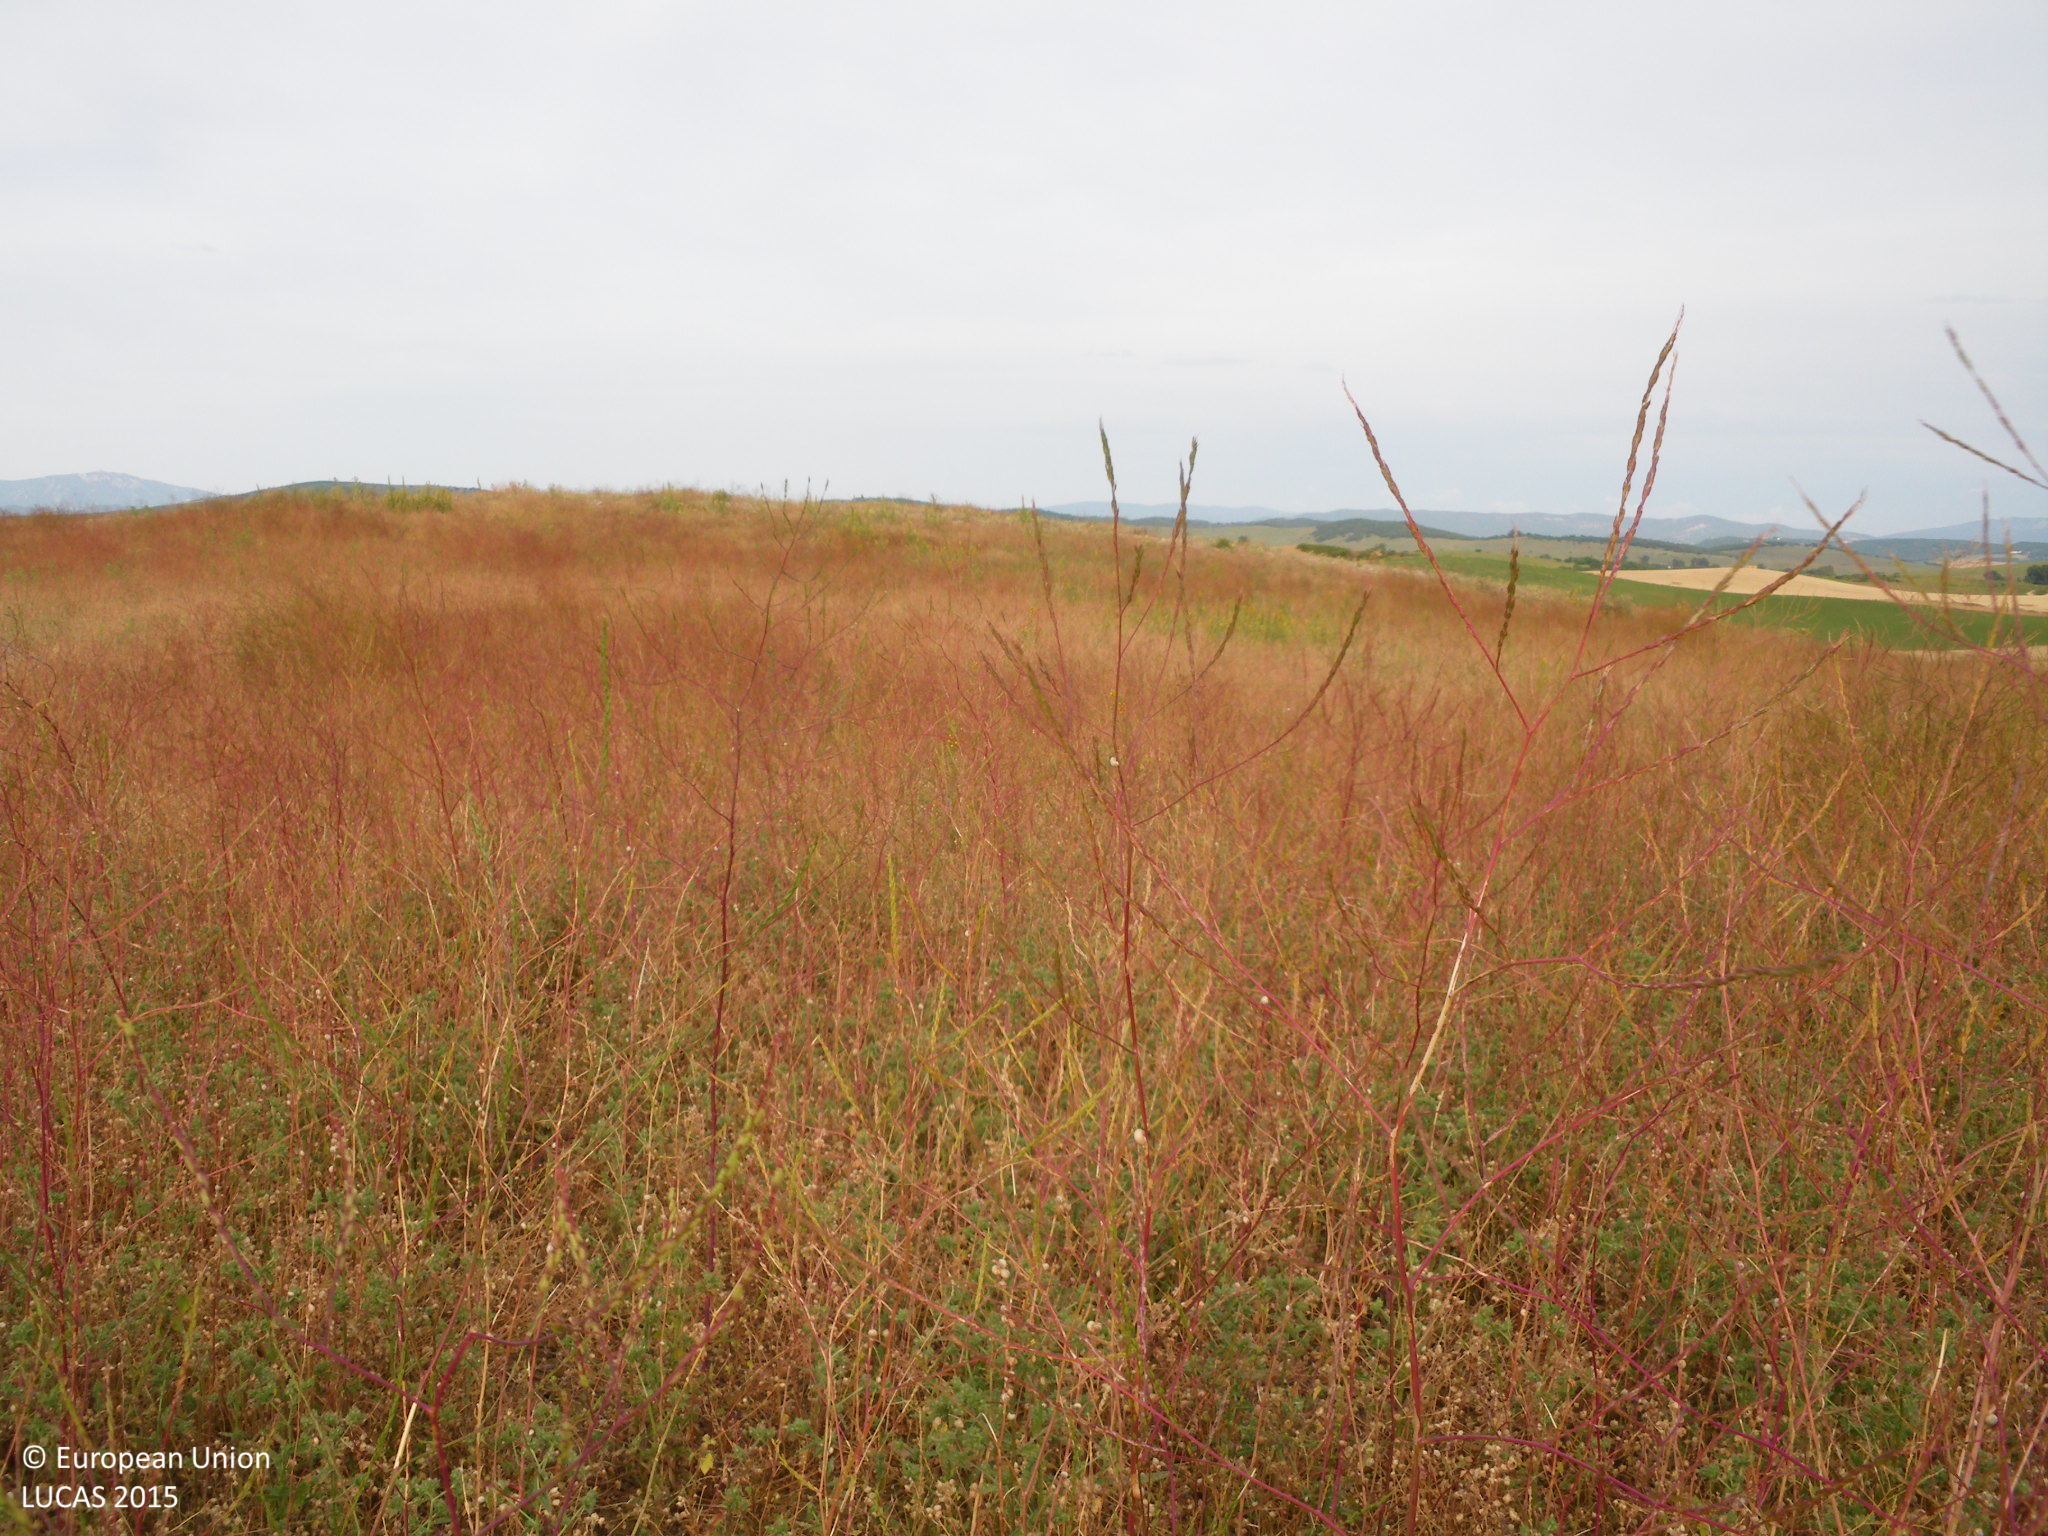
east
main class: Grassland
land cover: Spontaneously vegetated surfaces
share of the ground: > 75 %
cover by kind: herbaceous plants 95 %, unconsolidated bare surface 5 %
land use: Agriculture (excluding fallow land and kitchen gardens)
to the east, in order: Spontaneously vegetated surfaces
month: May
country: ES
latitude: 36.3981
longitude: -5.9137
